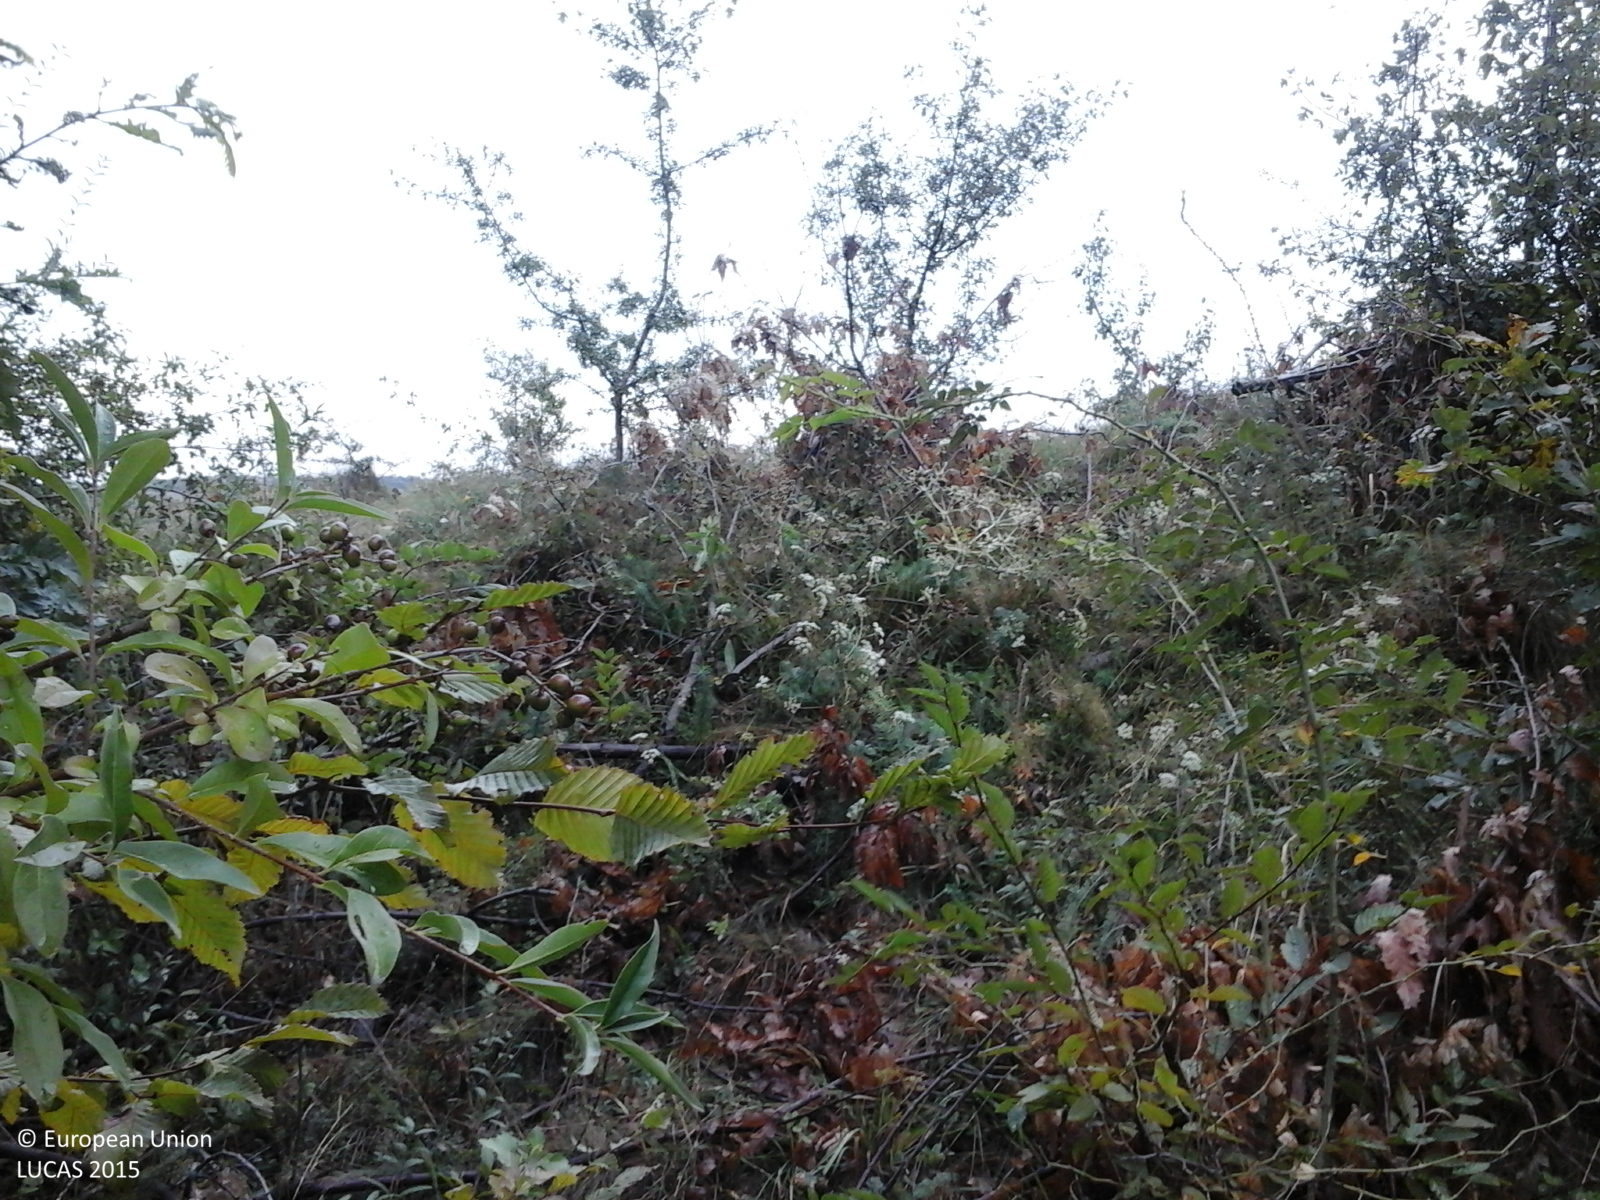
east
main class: Woodland
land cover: Broadleaved woodland
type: beech forest
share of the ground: > 75 %
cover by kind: broadleaved forest trees 100 %
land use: Forestry
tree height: > 5 m
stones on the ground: < 10 %
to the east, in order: Broadleaved woodland; Tracks; Spontaneously vegetated surfaces
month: September
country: RO
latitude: 47.1343
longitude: 22.1128
